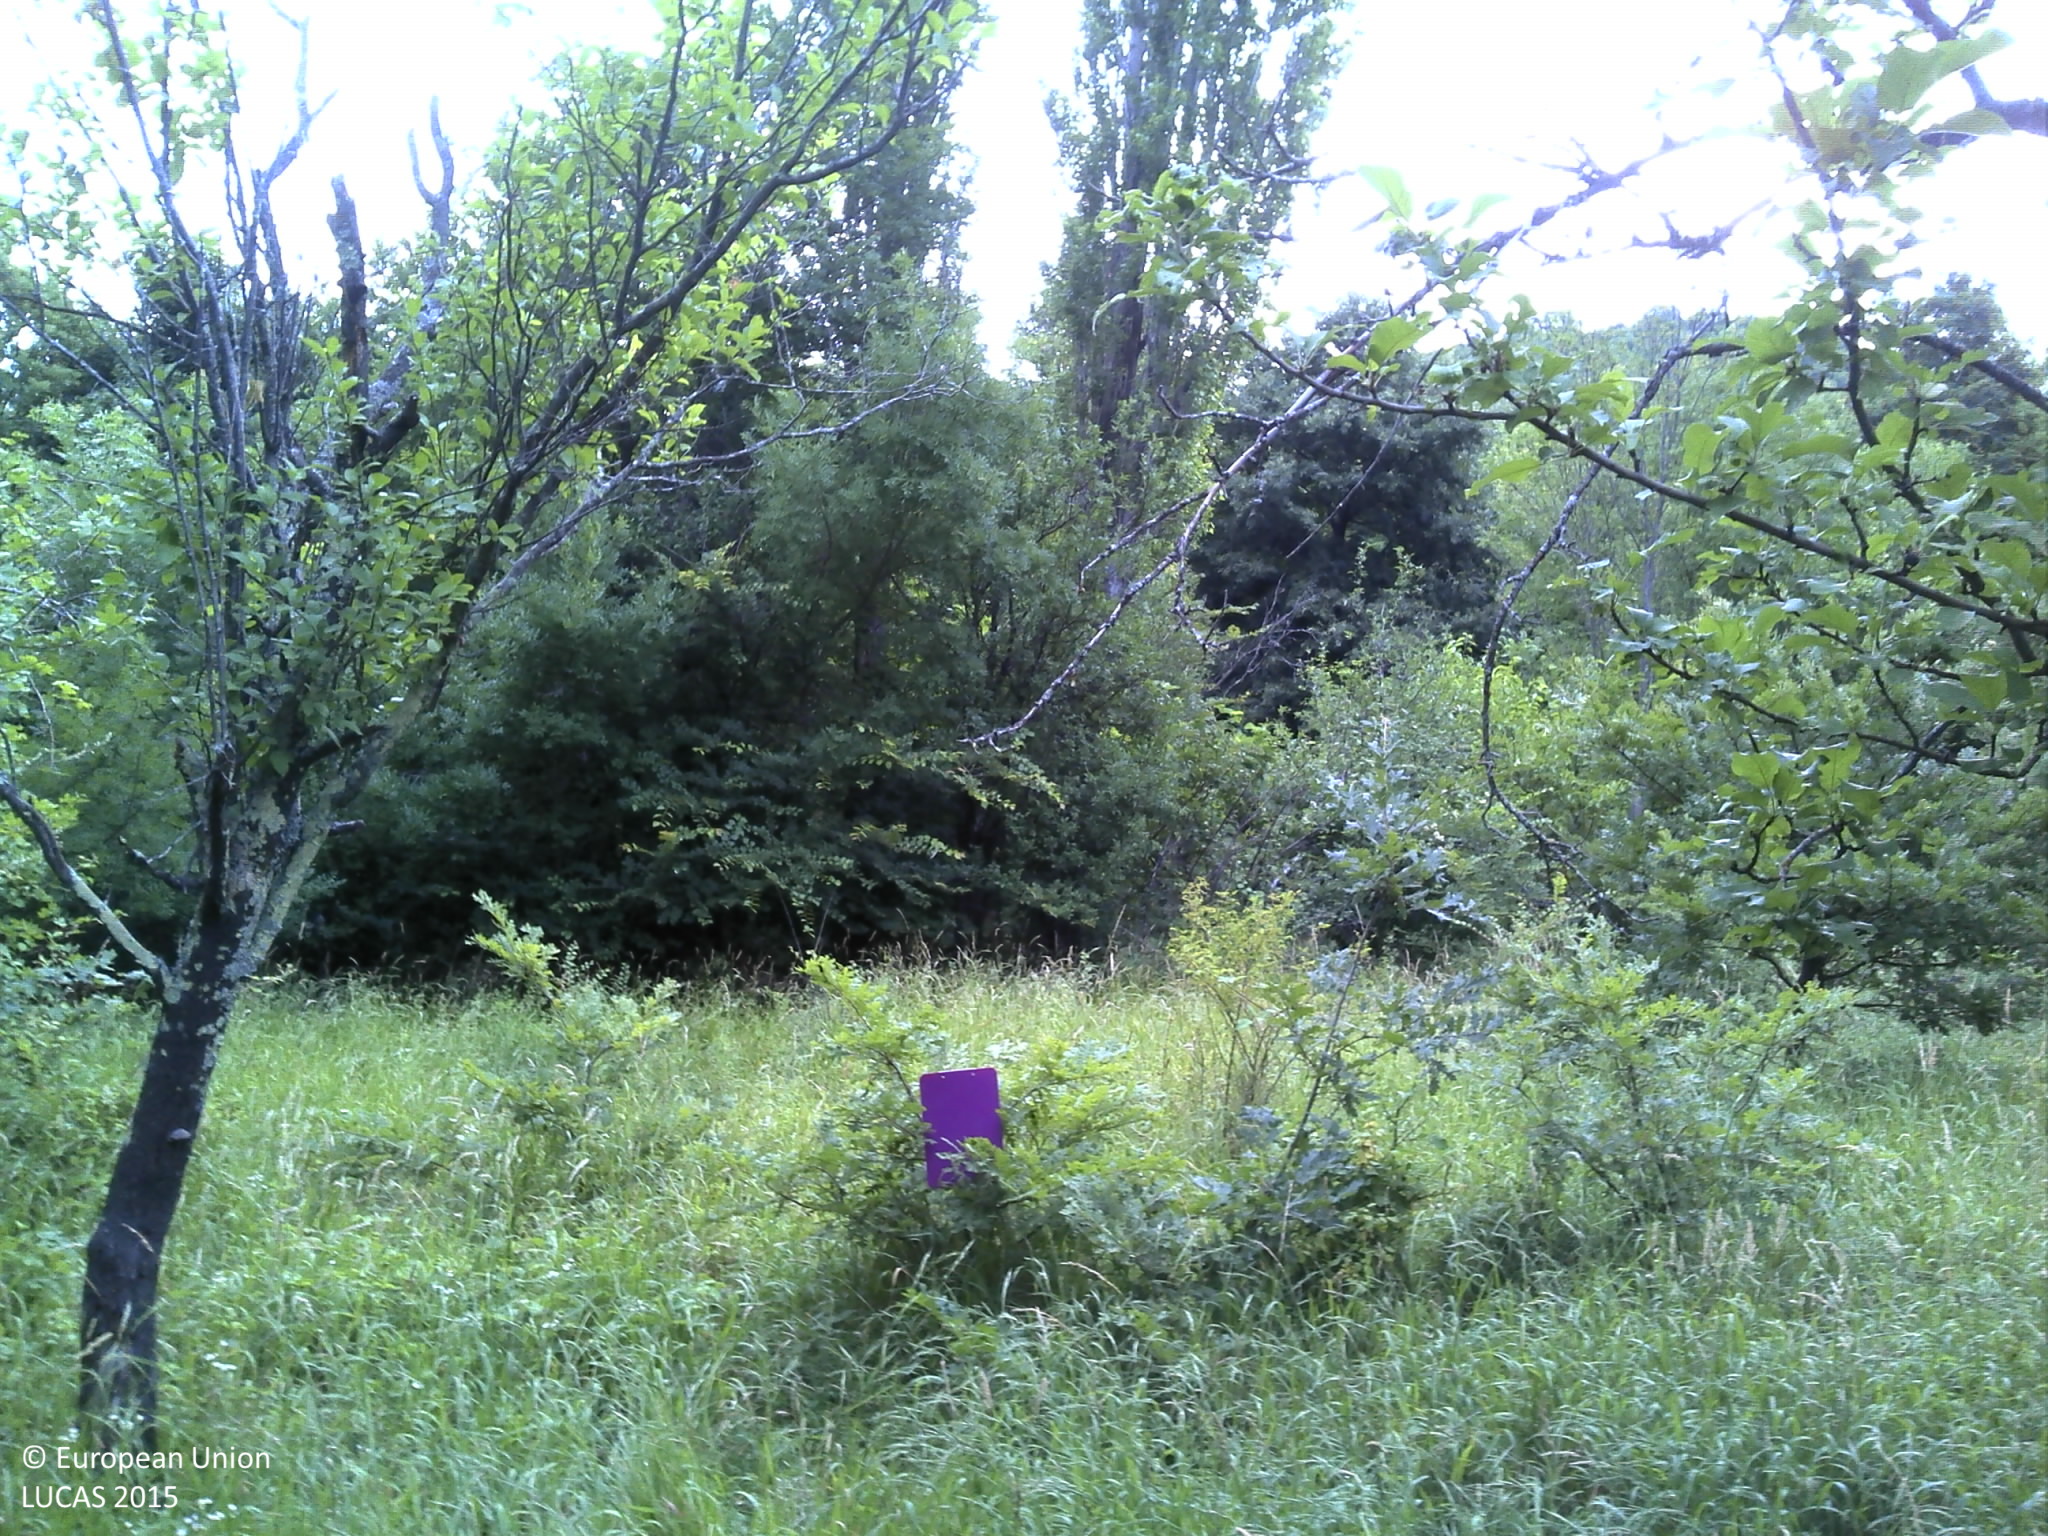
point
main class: Woodland
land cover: Broadleaved woodland
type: mesophytic deciduous forest
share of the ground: 25 - 50 %
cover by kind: broadleaved forest trees 40 %, shrubs 30 %, herbaceous plants 30 %
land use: Semi-natural and natural areas not in use
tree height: > 5 m
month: June
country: HR
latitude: 44.1915
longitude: 16.0608
